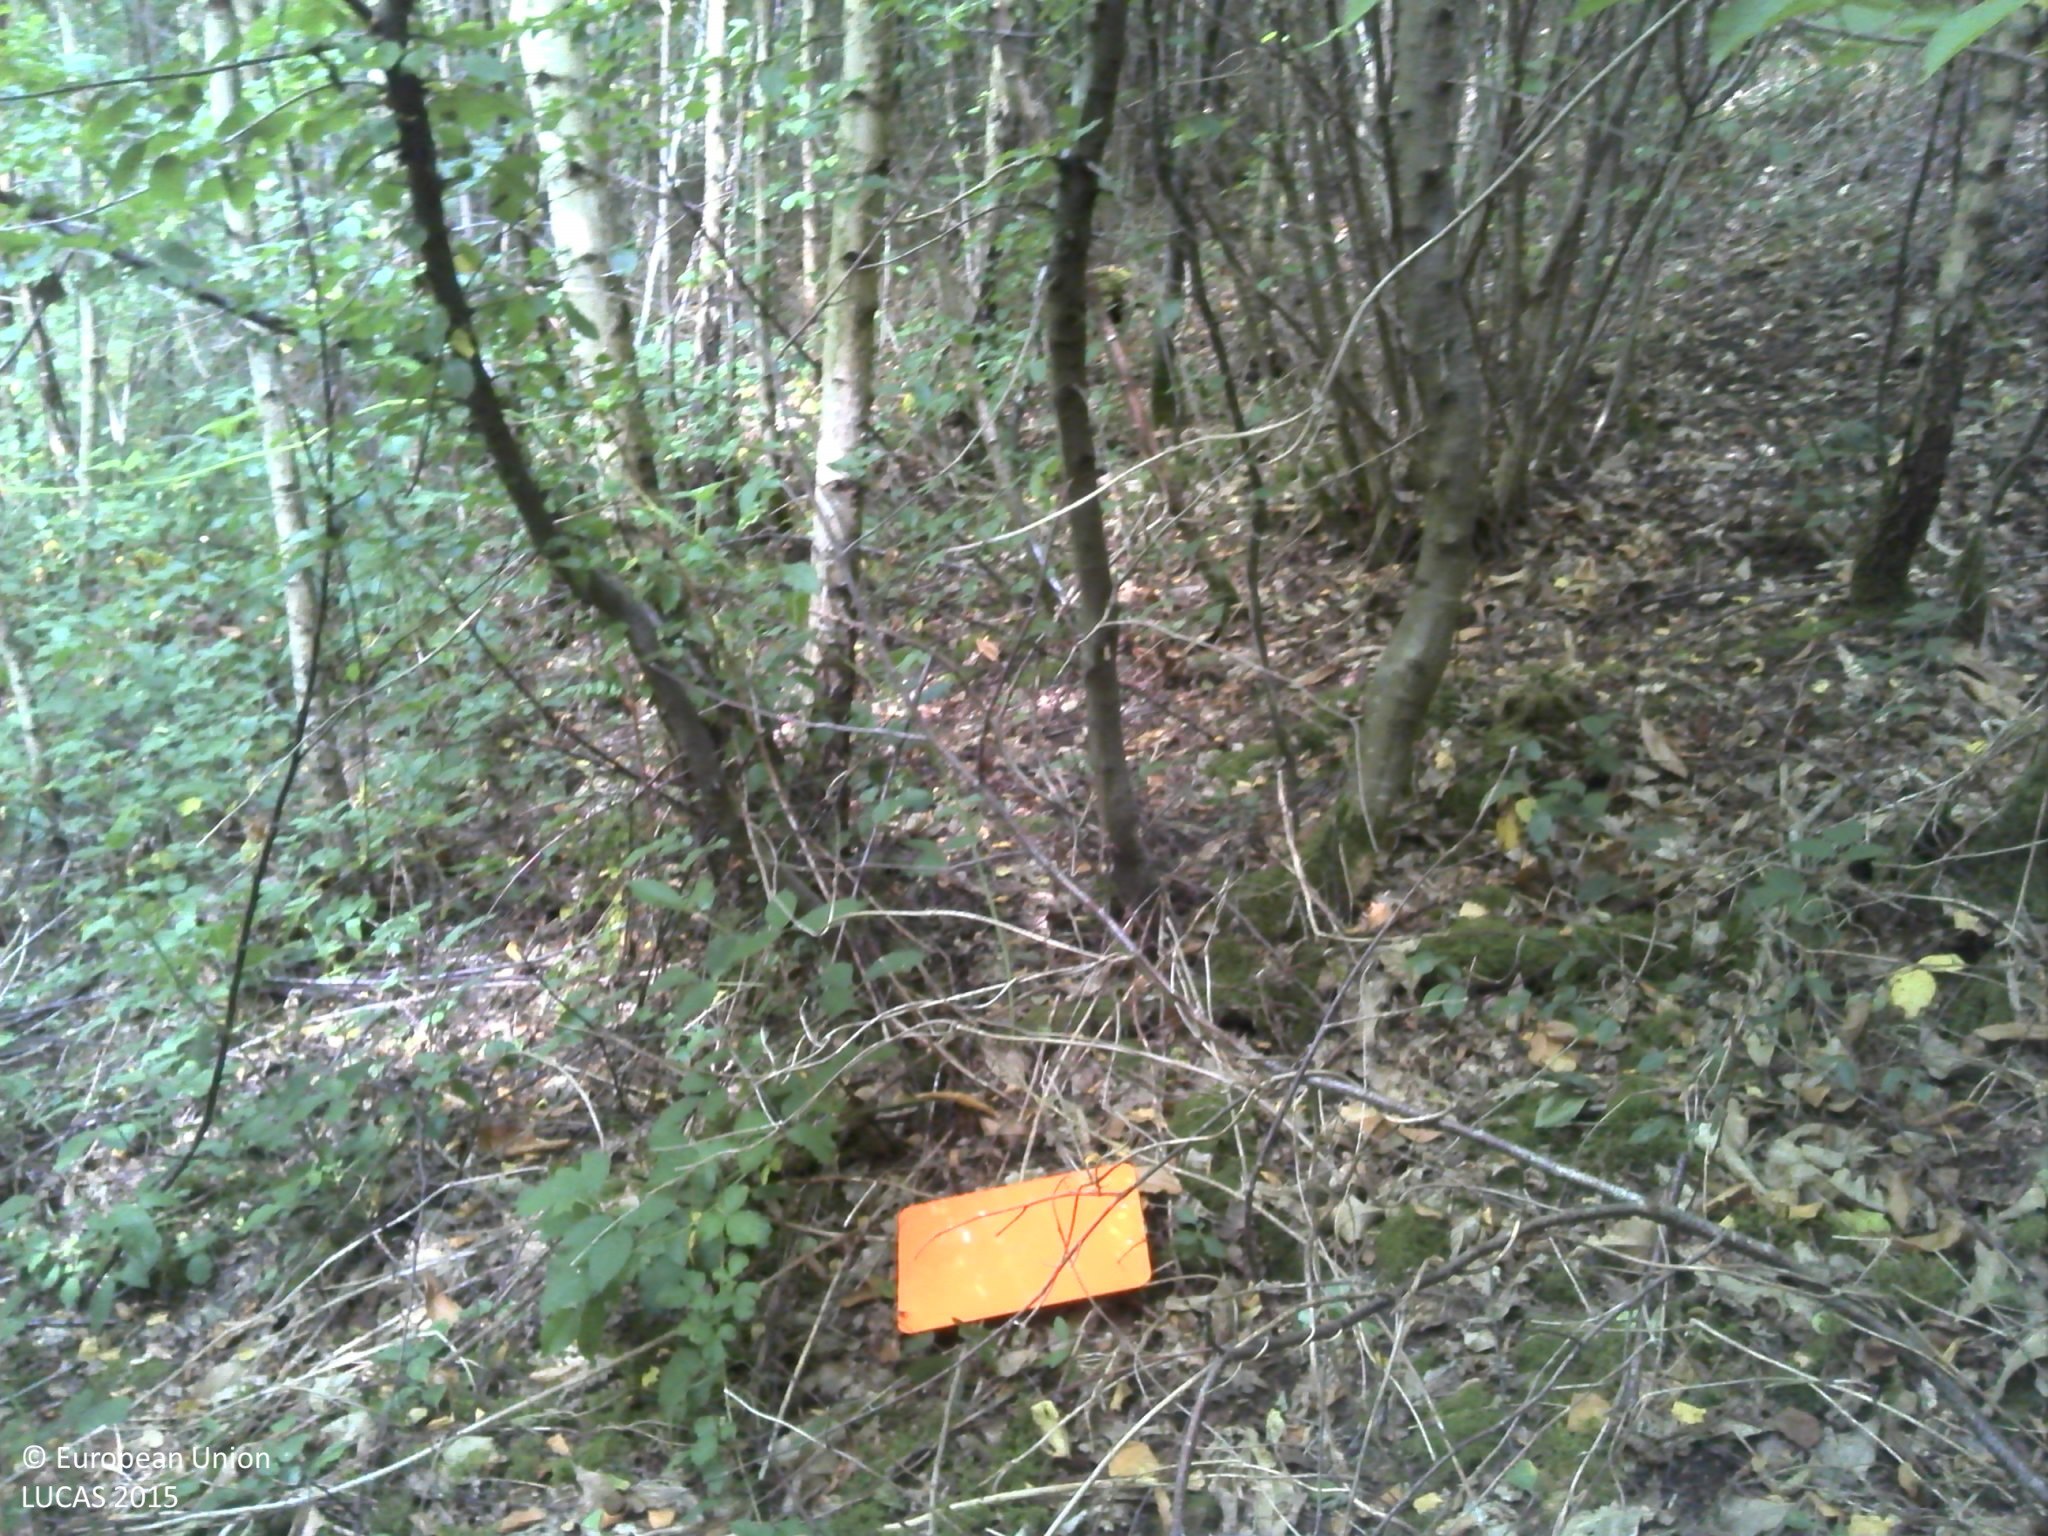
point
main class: Woodland
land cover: Broadleaved woodland
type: beech forest
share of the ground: > 75 %
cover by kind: broadleaved forest trees 70 %, herbaceous plants 20 %, consolidated bare surface 10 %
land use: Forestry
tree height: > 5 m
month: July
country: FR
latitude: 49.3618
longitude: 4.7786
